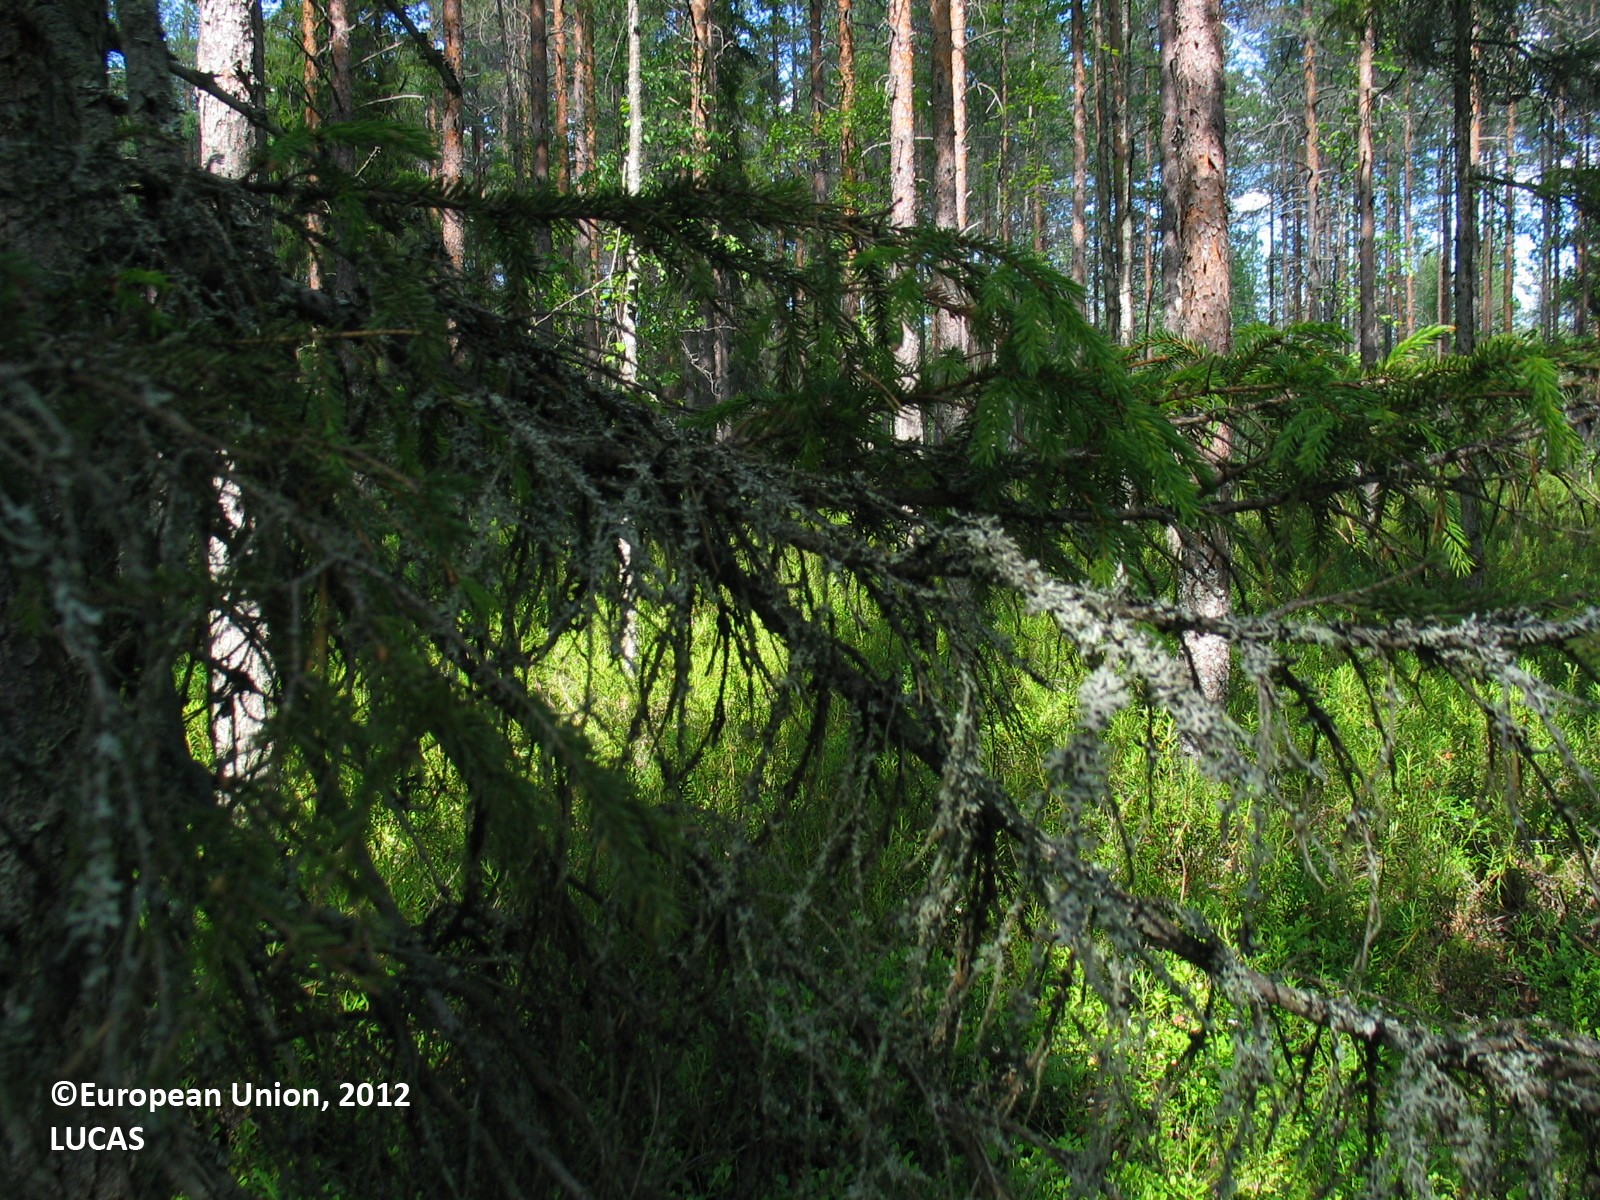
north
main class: Woodland
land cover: Pine dominated coniferous woodland
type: mire and swamp forests
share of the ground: 50 - 75 %
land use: Forestry
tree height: > 5 m
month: July
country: FI
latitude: 64.7082
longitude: 26.5388
